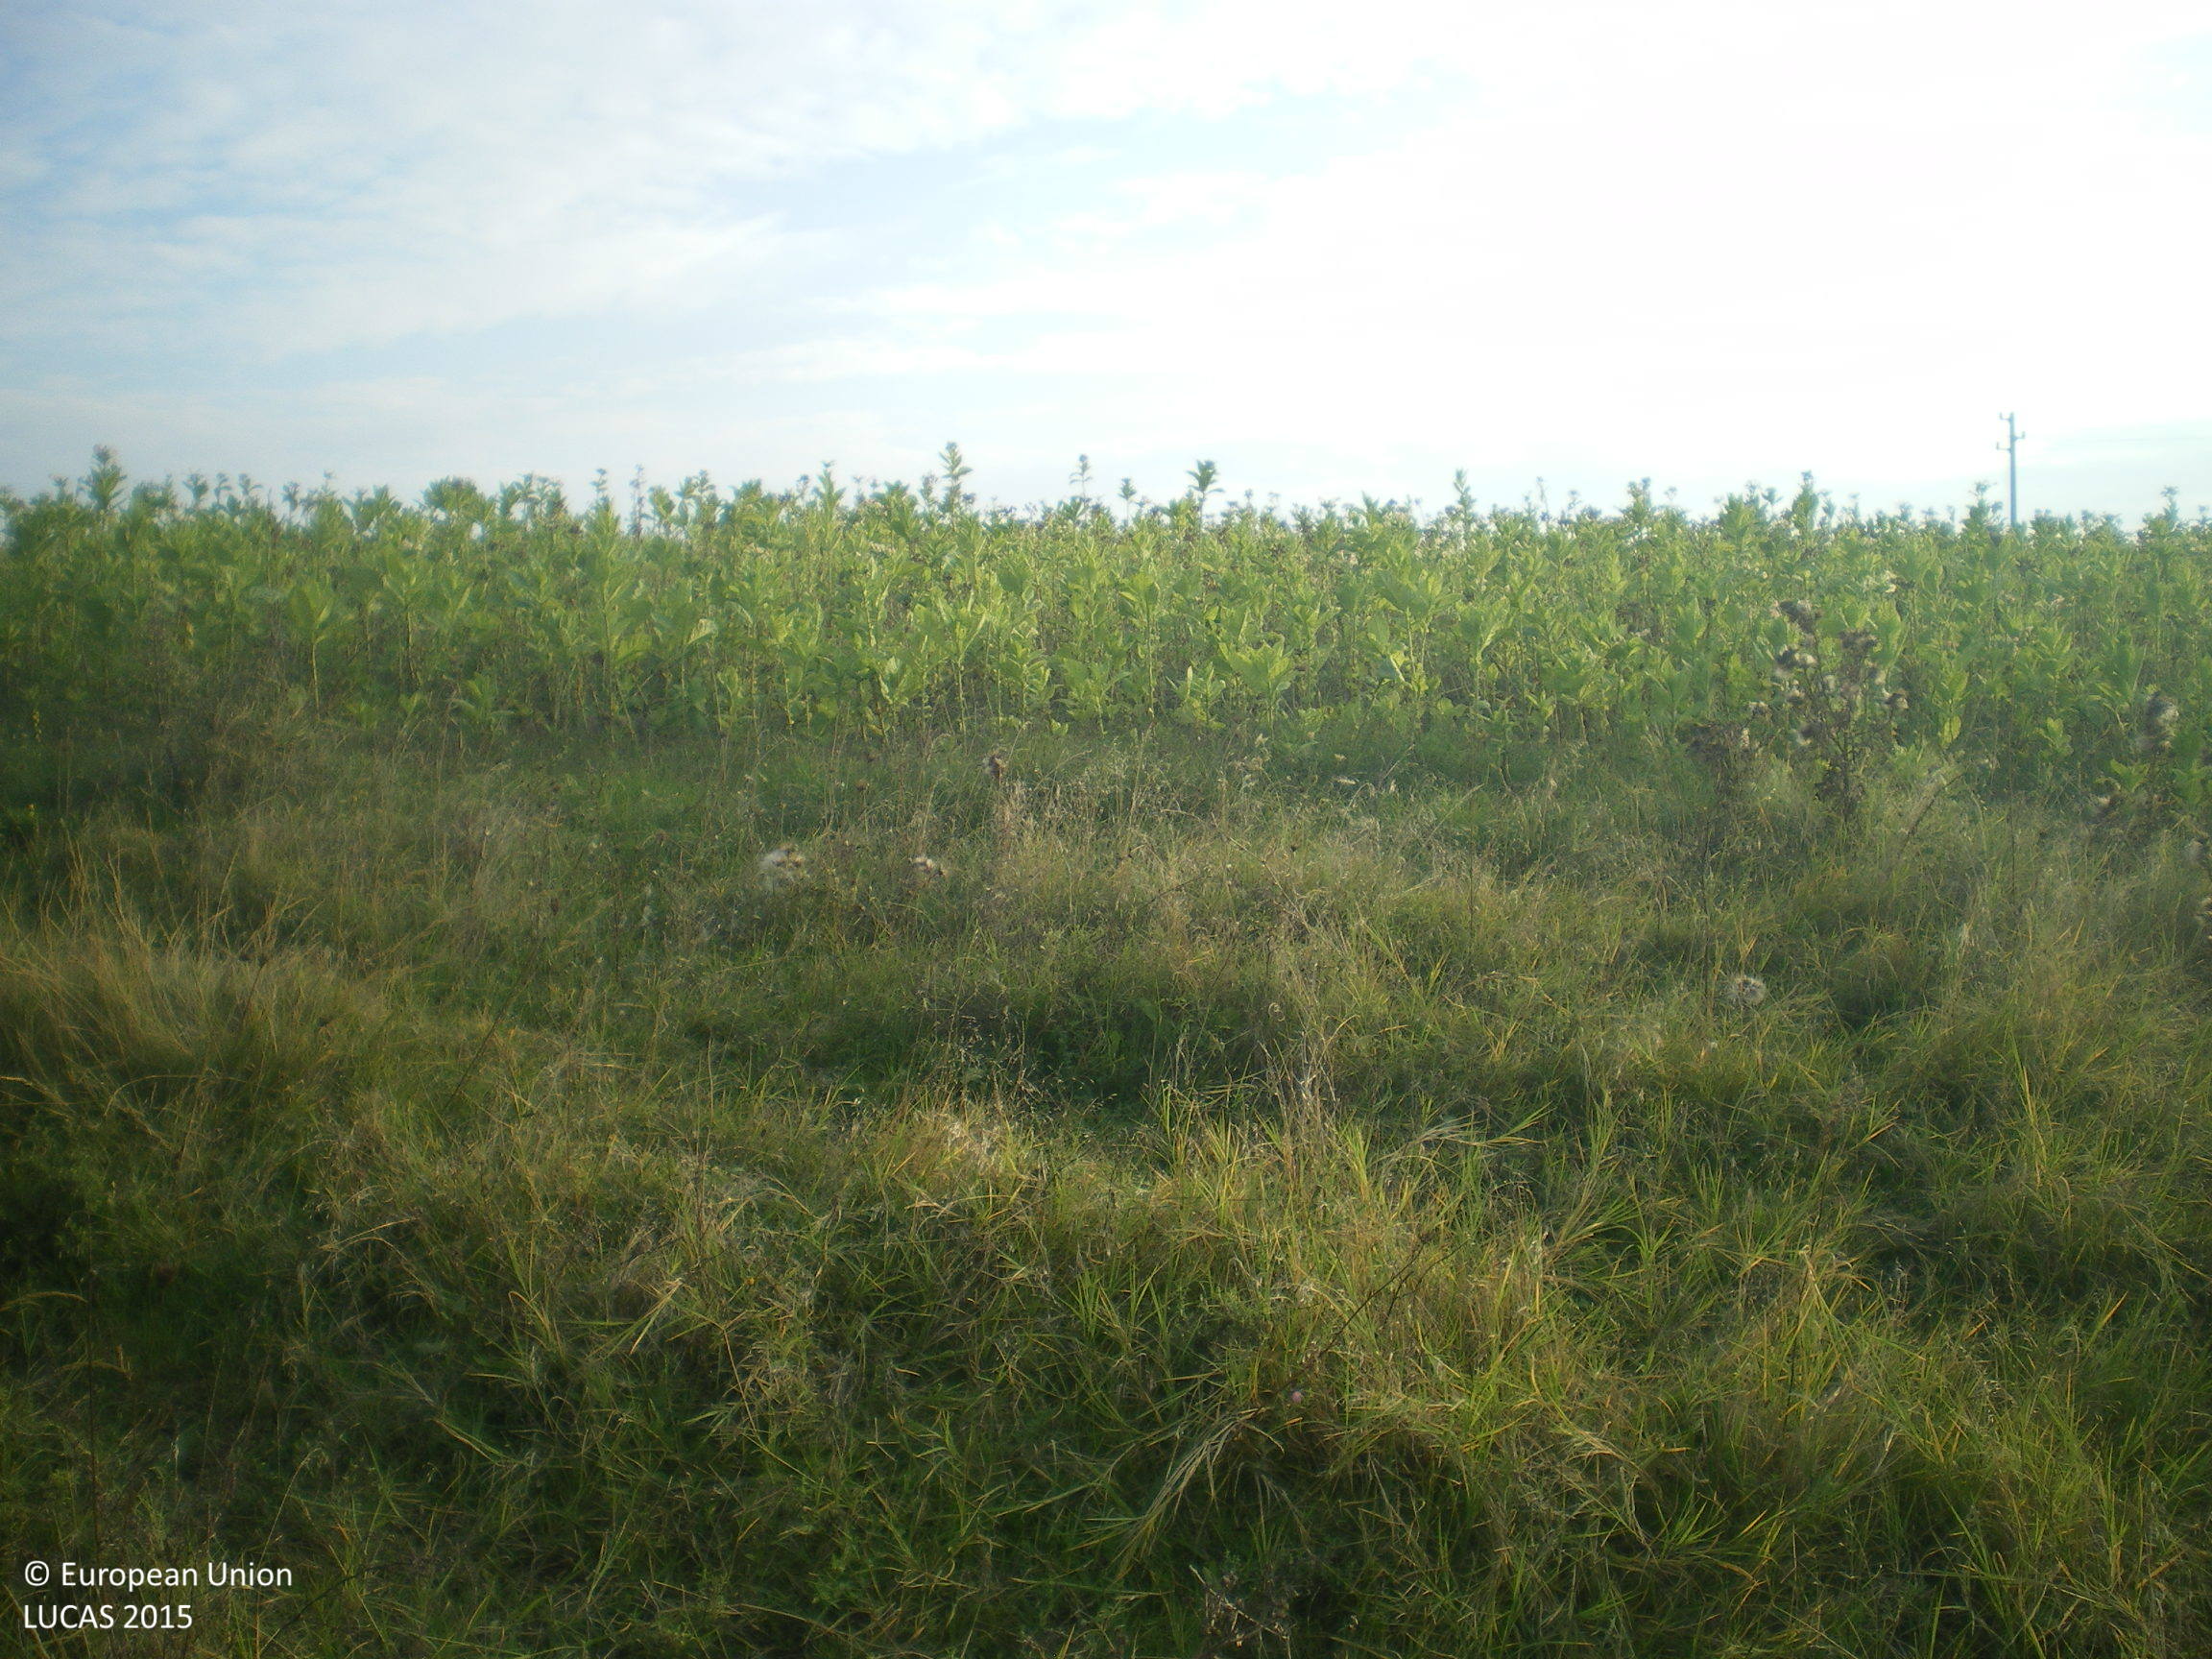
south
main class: Shrubland
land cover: Shrubland without tree cover
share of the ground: > 75 %
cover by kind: shrubs 70 %, herbaceous plants 30 %
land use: Semi-natural and natural areas not in use
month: October
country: BG
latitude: 41.8733
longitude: 26.3095
